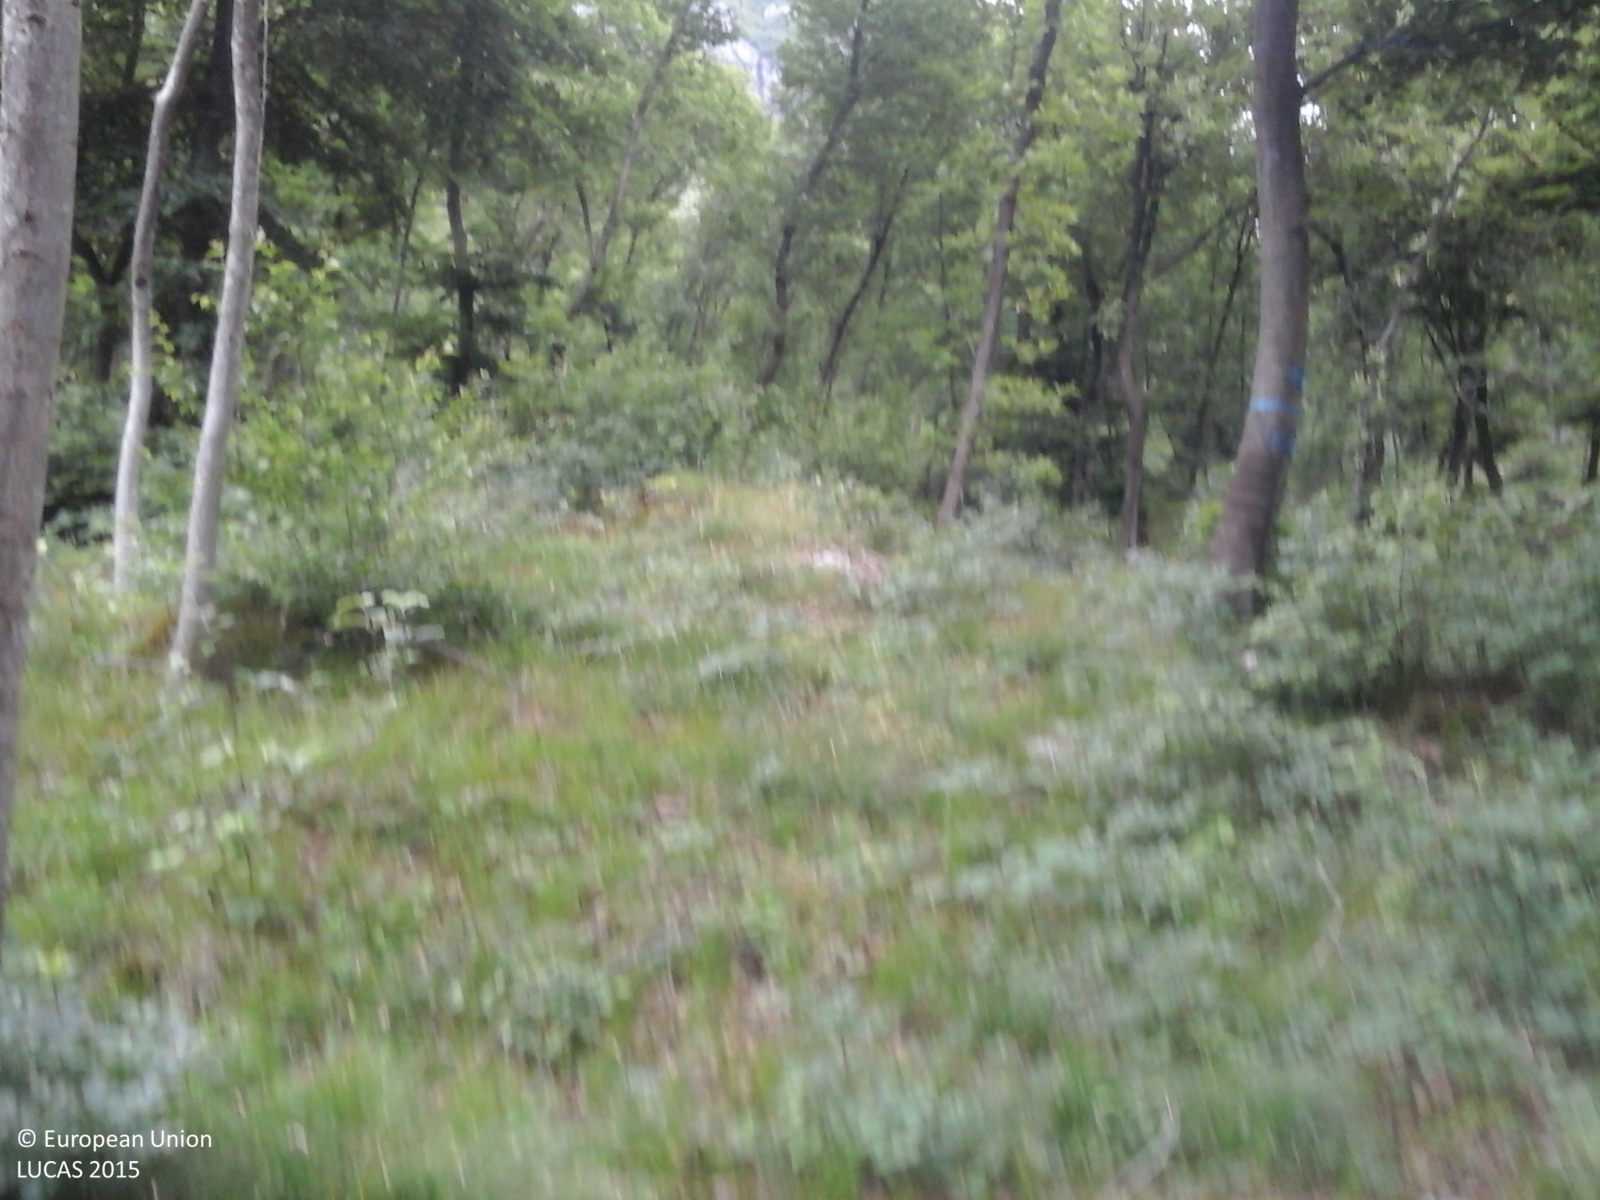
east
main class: Woodland
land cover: Broadleaved woodland
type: mountainous beech forest
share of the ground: > 75 %
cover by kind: broadleaved forest trees 90 %, herbaceous plants 10 %
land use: Forestry
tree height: > 5 m
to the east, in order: Broadleaved woodland; Tracks; Broadleaved woodland
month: May
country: IT
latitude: 45.6985
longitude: 10.9360
